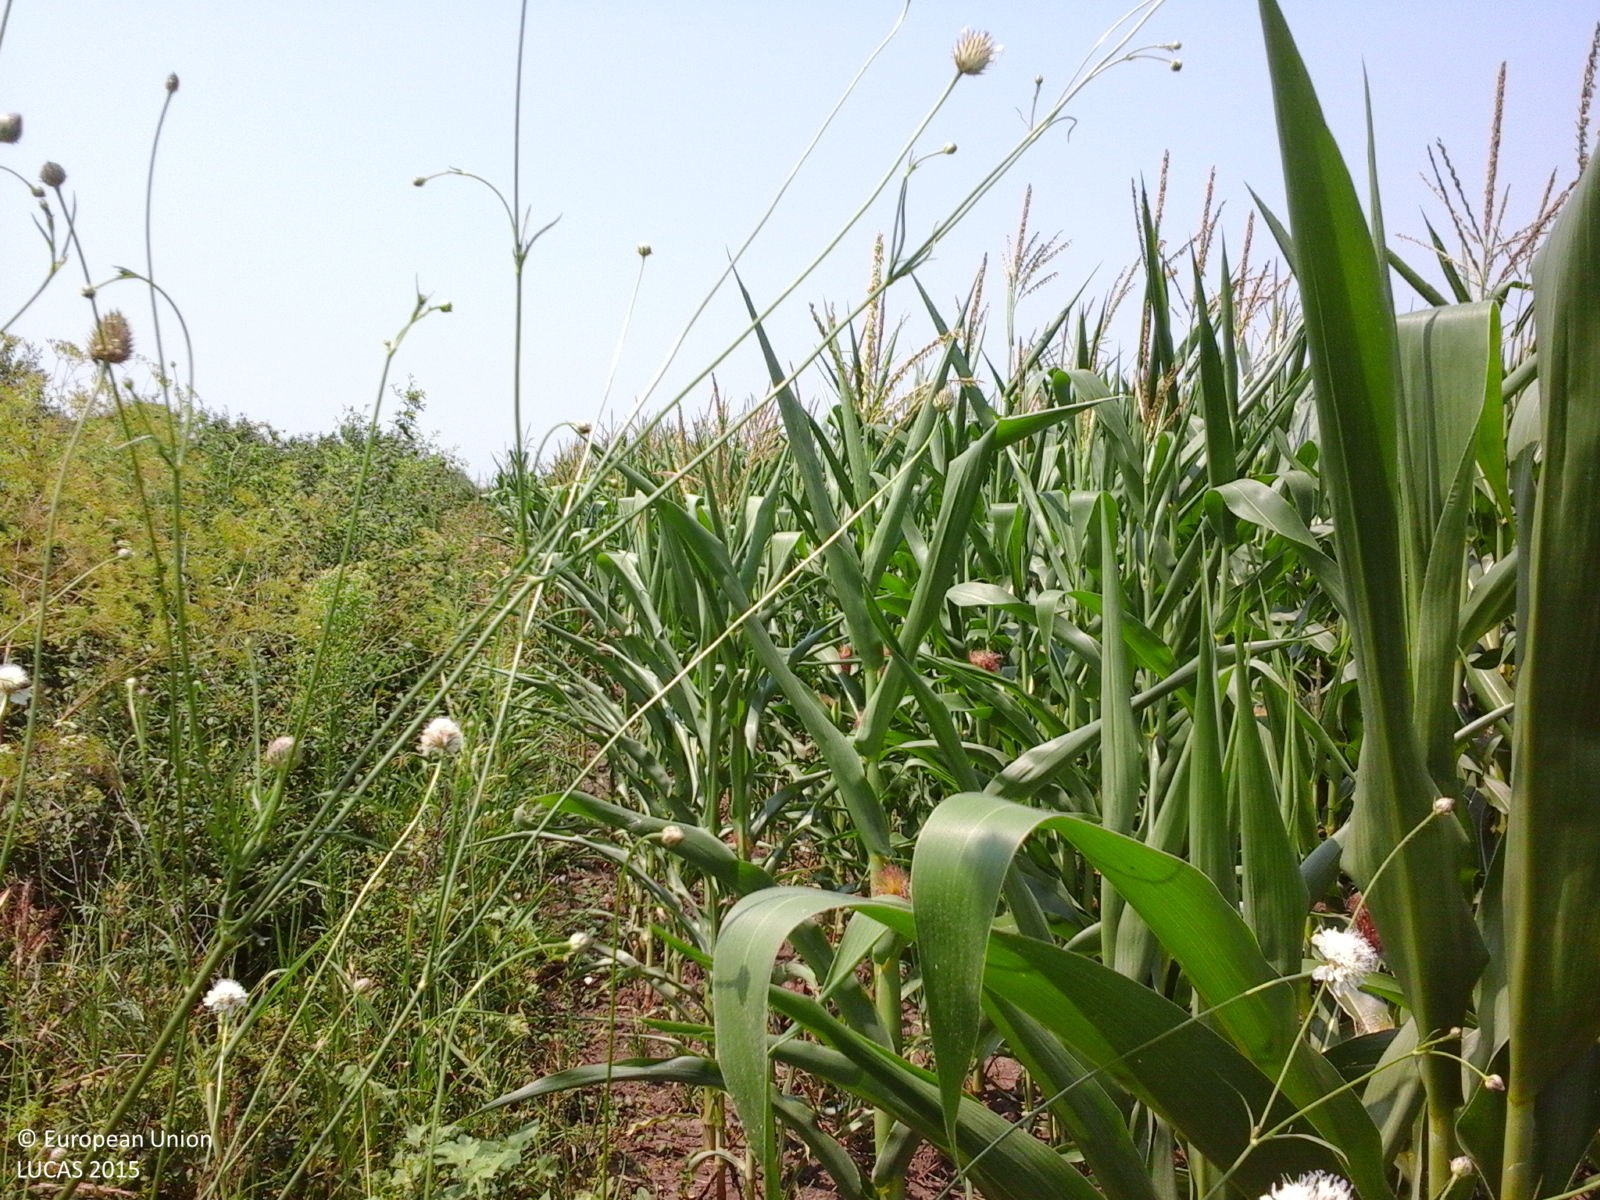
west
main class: Cropland
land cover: Maize
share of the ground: > 75 %
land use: Agriculture (excluding fallow land and kitchen gardens)
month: July
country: RO
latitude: 44.7640
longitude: 26.2717
